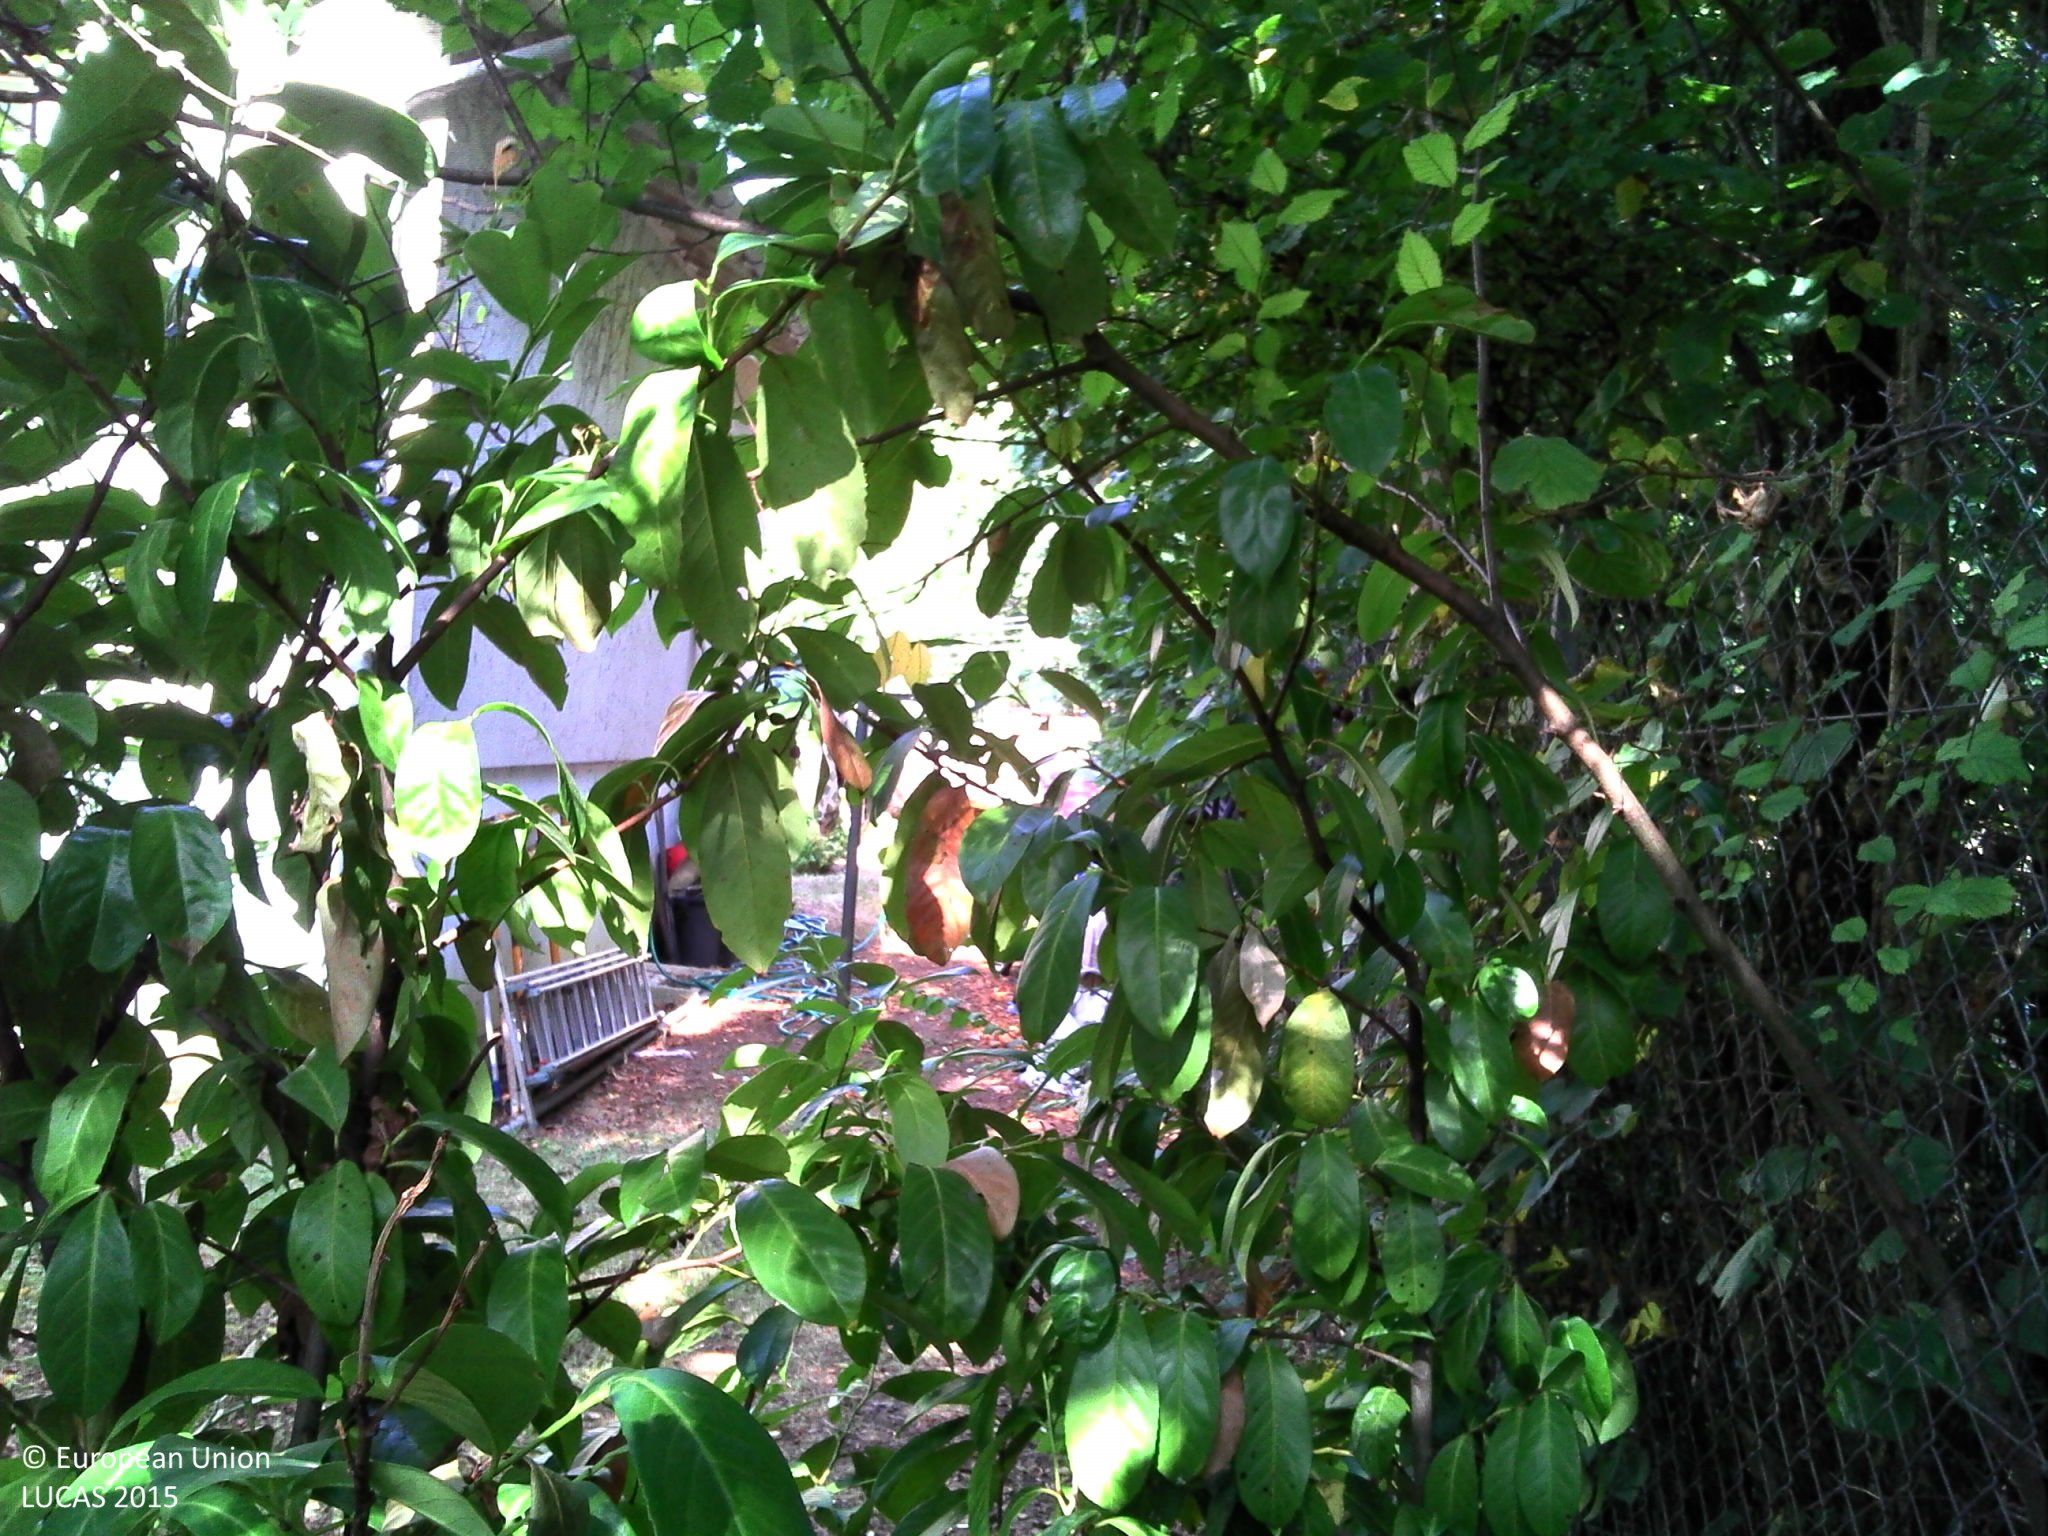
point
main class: Grassland
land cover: Grassland with sparse tree/shrub cover
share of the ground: > 75 %
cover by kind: herbaceous plants 95 %, broadleaved forest trees 5 %
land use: Amenities, museums, leisure
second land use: Residential
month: August
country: FR
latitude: 47.7998
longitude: 3.5470
